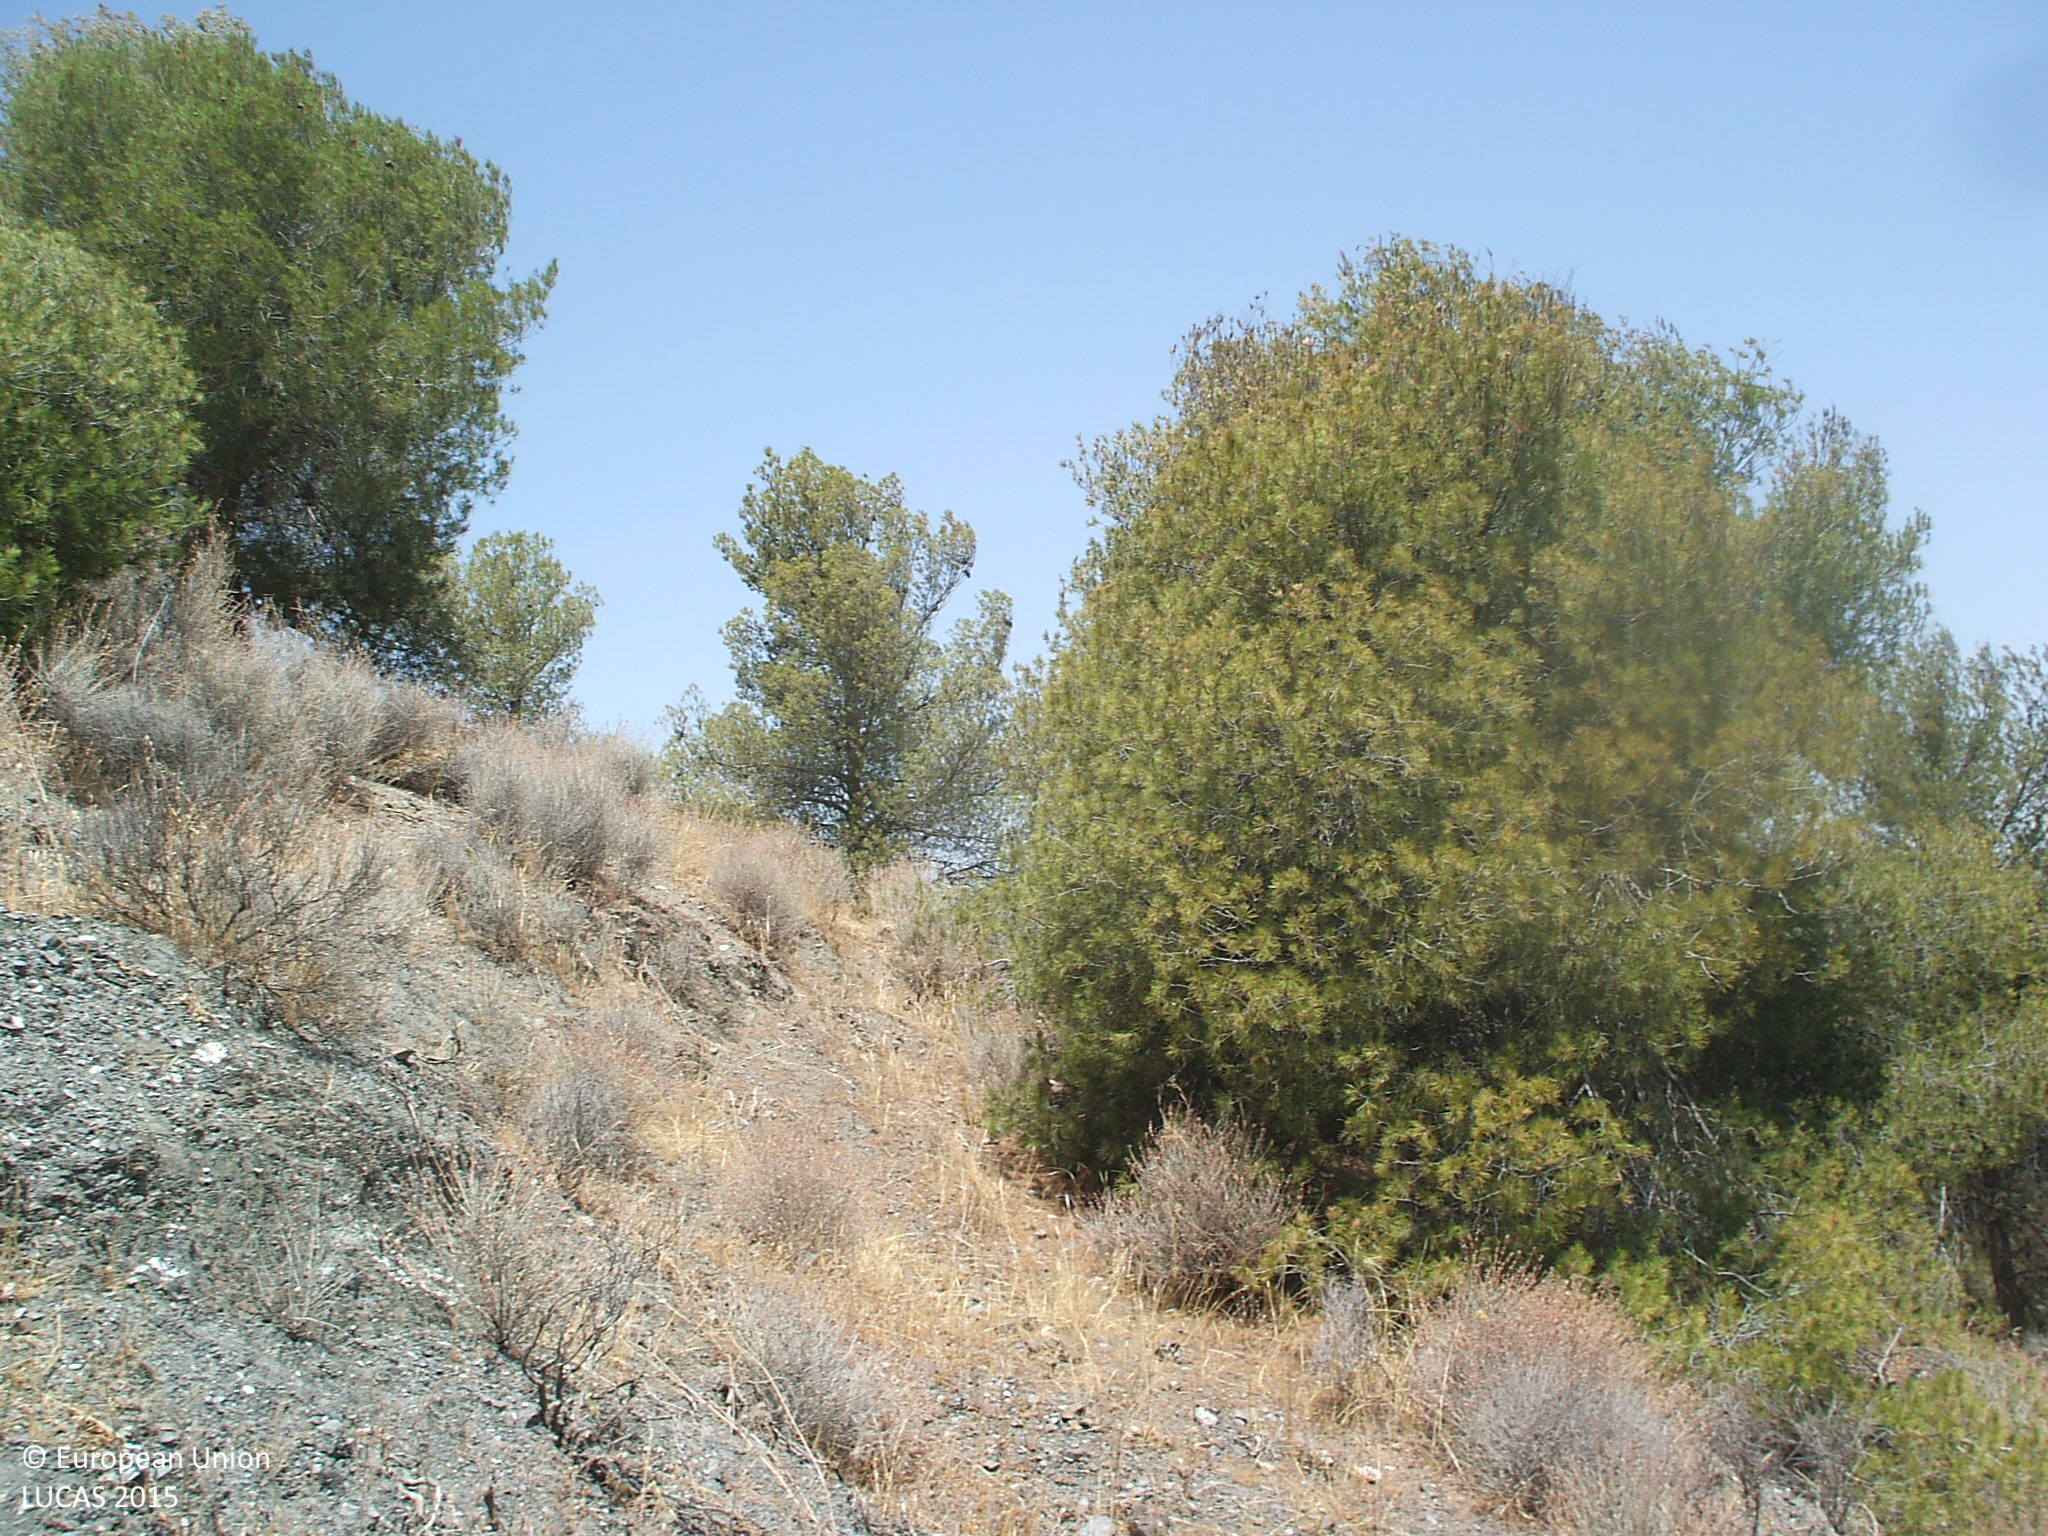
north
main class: Woodland
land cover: Pine dominated coniferous woodland
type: coniferous forest of the mediterranean region
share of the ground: 25 - 50 %
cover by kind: consolidated bare surface 50 %, coniferous forest trees 30 %, shrubs 20 %
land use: Semi-natural and natural areas not in use
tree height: > 5 m
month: July
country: ES
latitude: 37.3375
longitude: -2.3866
